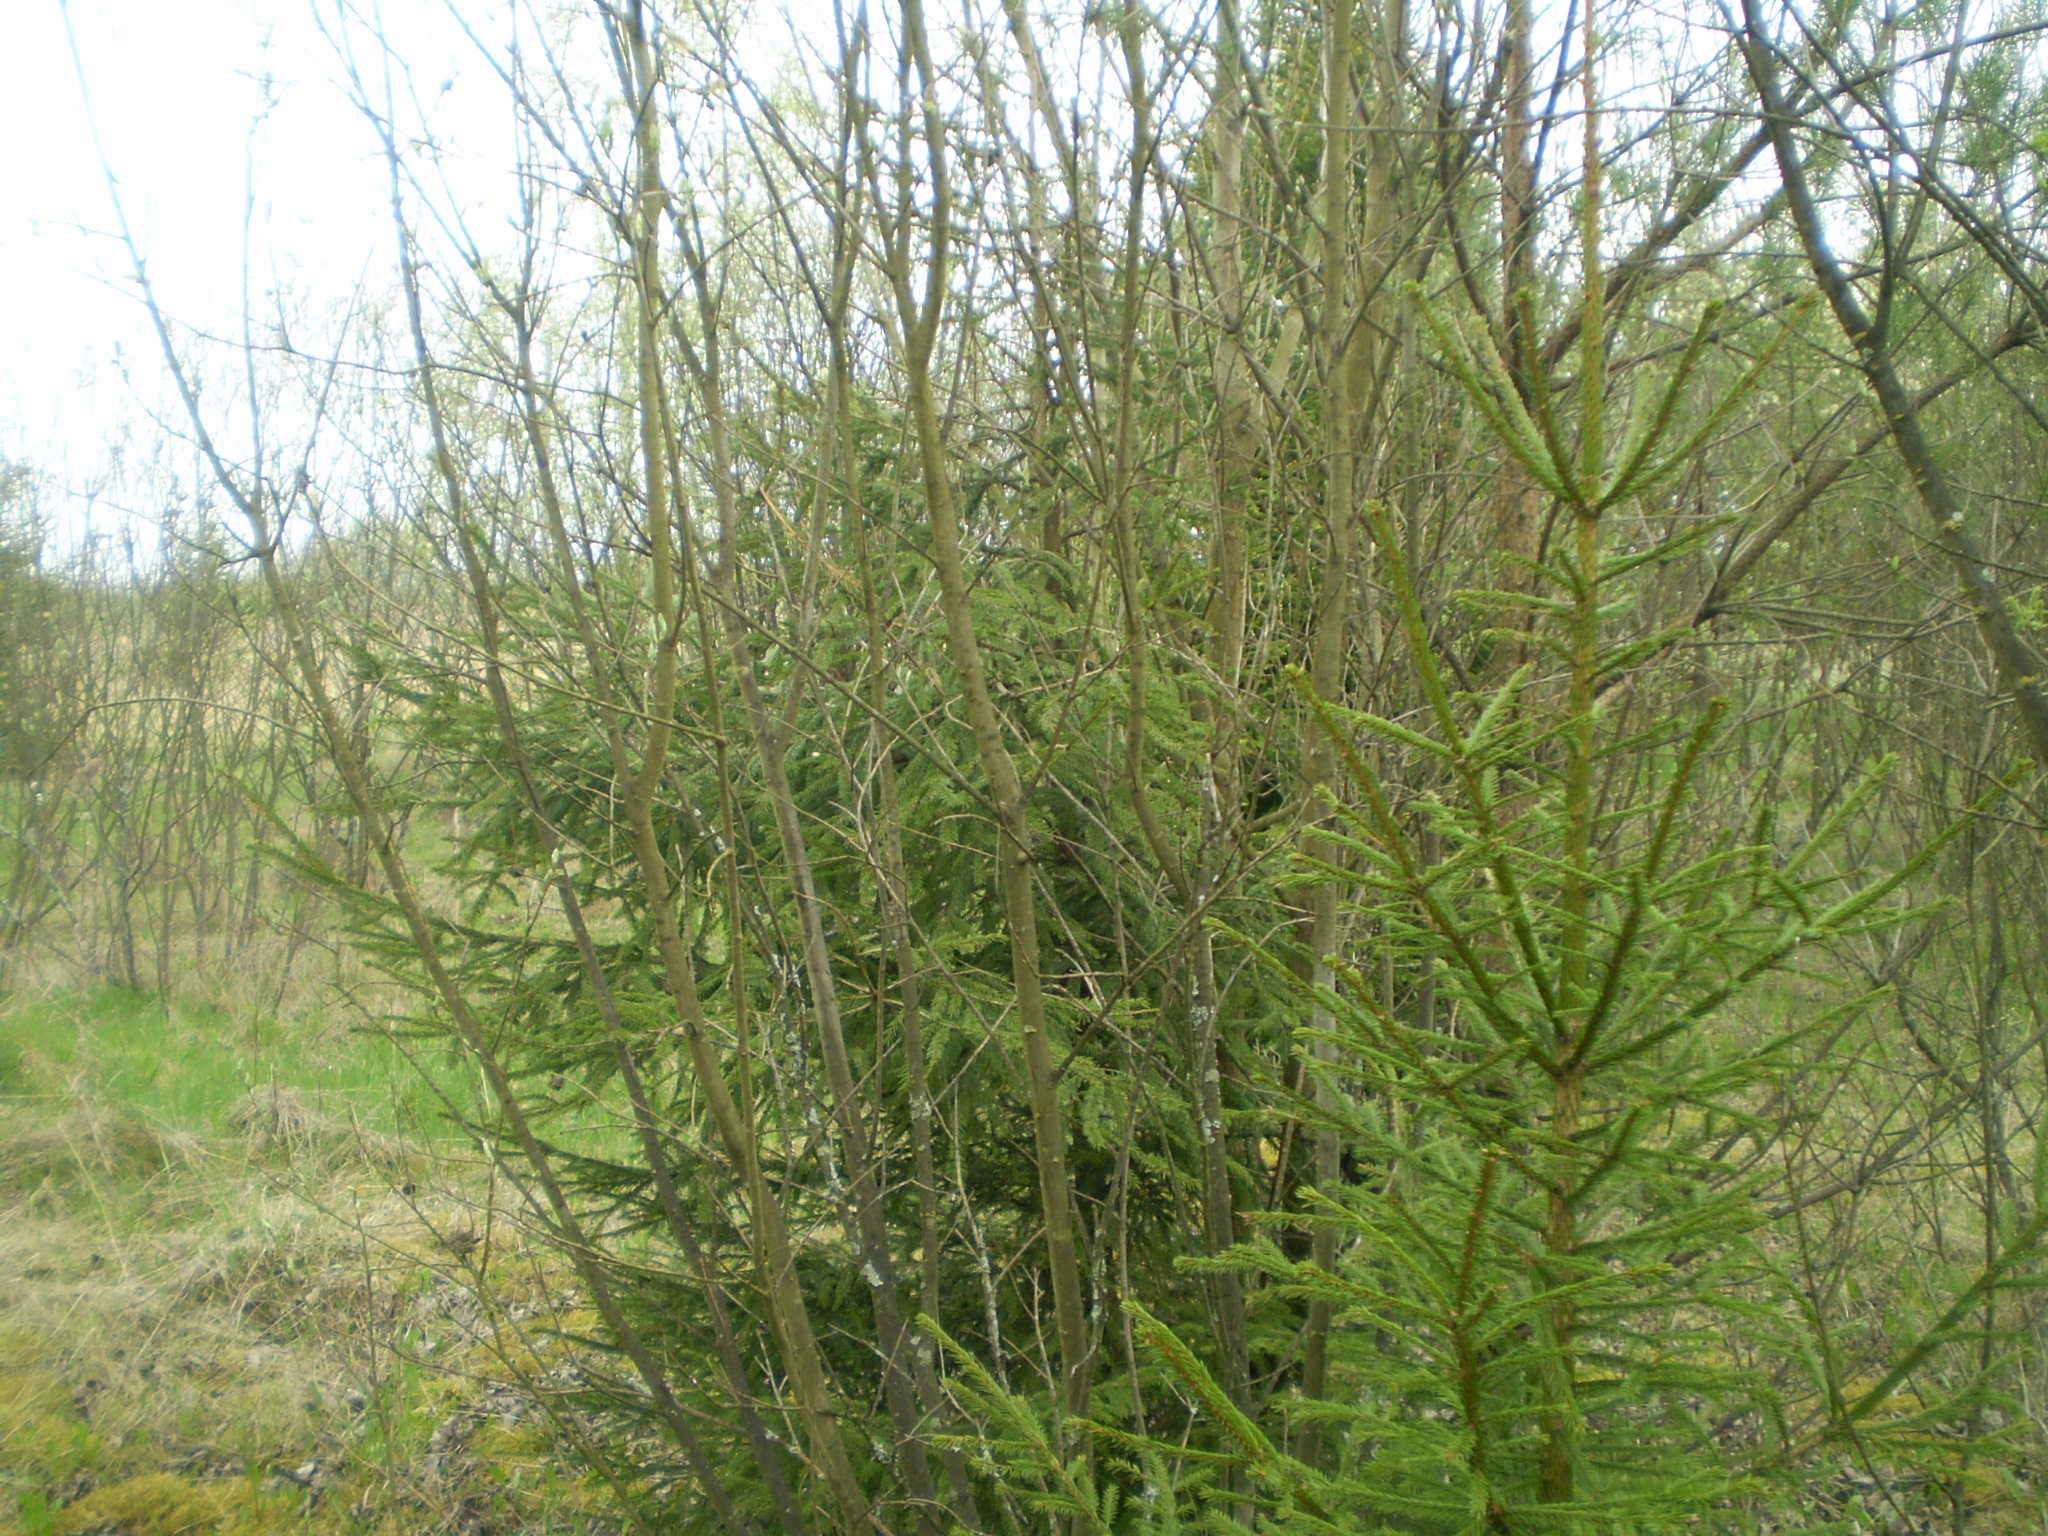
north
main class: Woodland
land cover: Other mixed woodland
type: hemiboreal forest and nemoral coniferous forest and mixed broadleaved-coniferous forest
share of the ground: > 75 %
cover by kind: broadleaved forest trees 65 %, coniferous forest trees 25 %, herbaceous plants 10 %
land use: Forestry
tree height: < 5 m
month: May
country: LT
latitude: 56.3905
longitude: 22.1525
